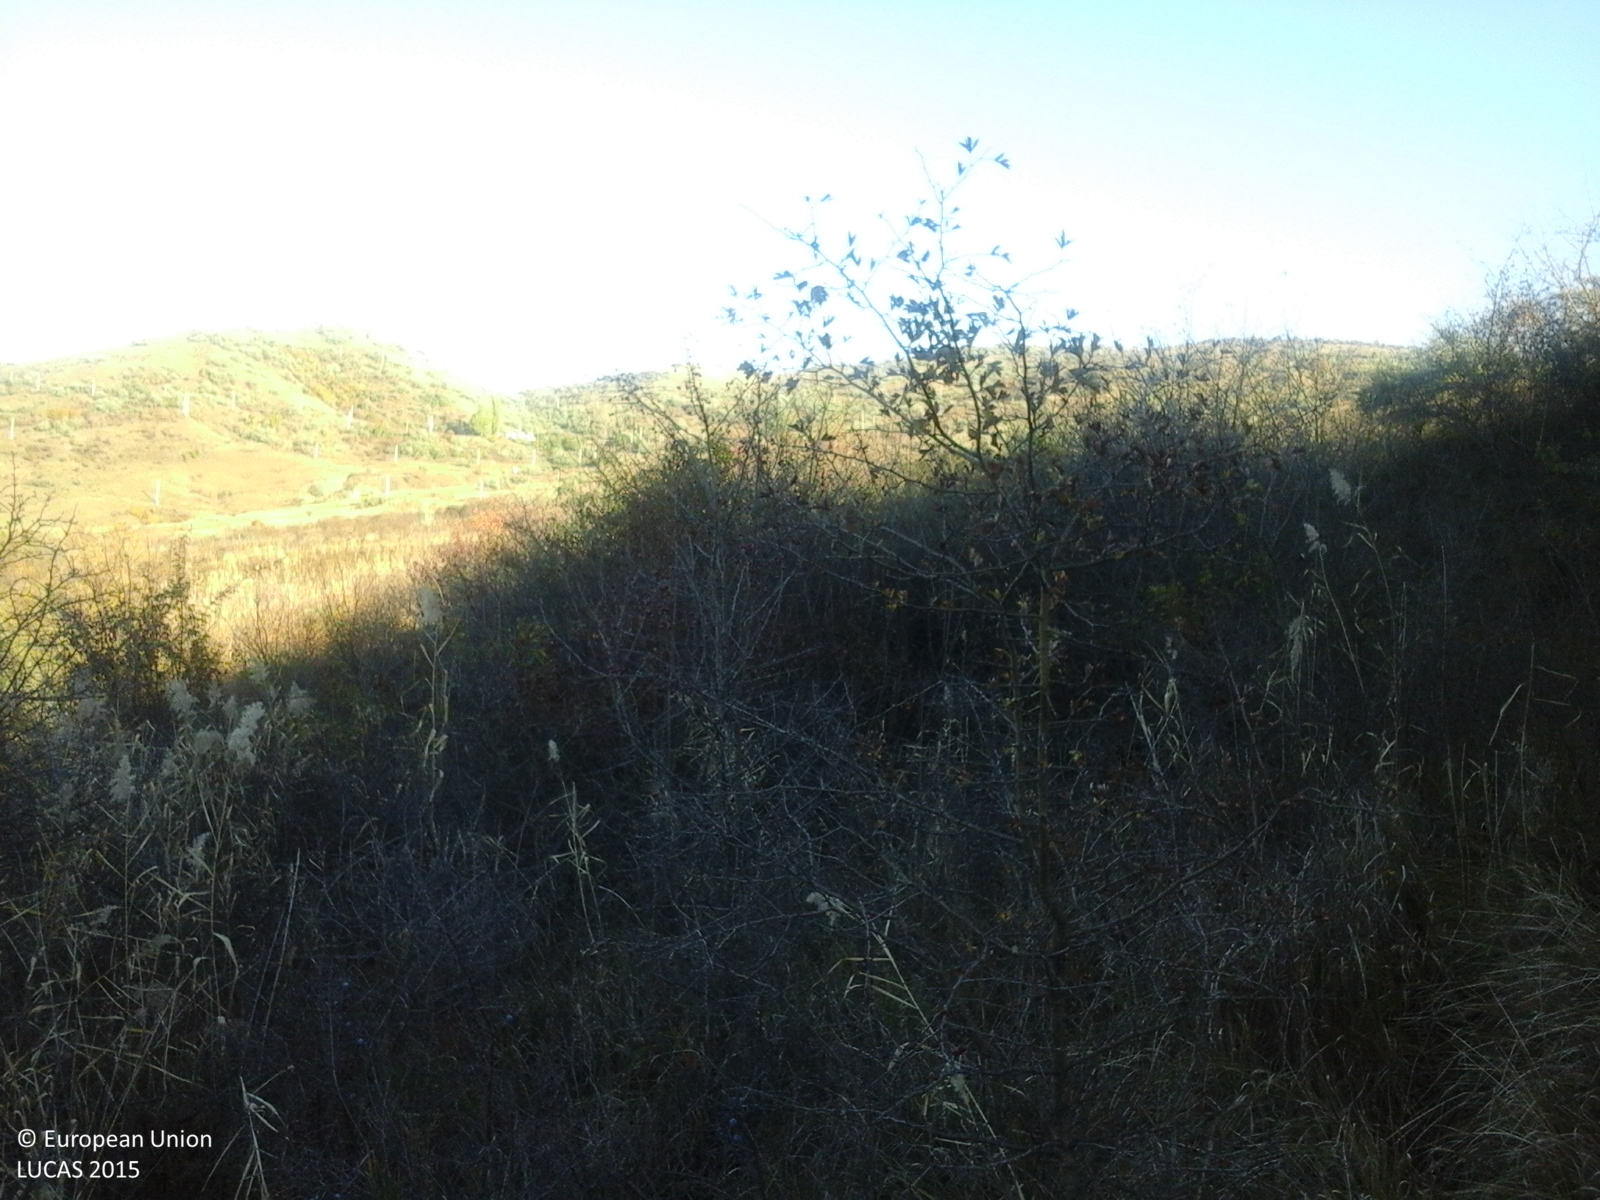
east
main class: Grassland
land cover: Grassland with sparse tree/shrub cover
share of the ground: > 75 %
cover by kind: herbaceous plants 85 %, shrubs 10 %, broadleaved forest trees 5 %
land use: Agriculture (excluding fallow land and kitchen gardens)
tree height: > 5 m
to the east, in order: Grassland with sparse tree/shrub cover; Shrubland with sparse tree cover; Grassland with sparse tree/shrub cover; Shrubland with sparse tree cover; Grassland with sparse tree/shrub cover; Shrubland with sparse tree cover
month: October
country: RO
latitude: 45.3203
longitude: 26.7007
